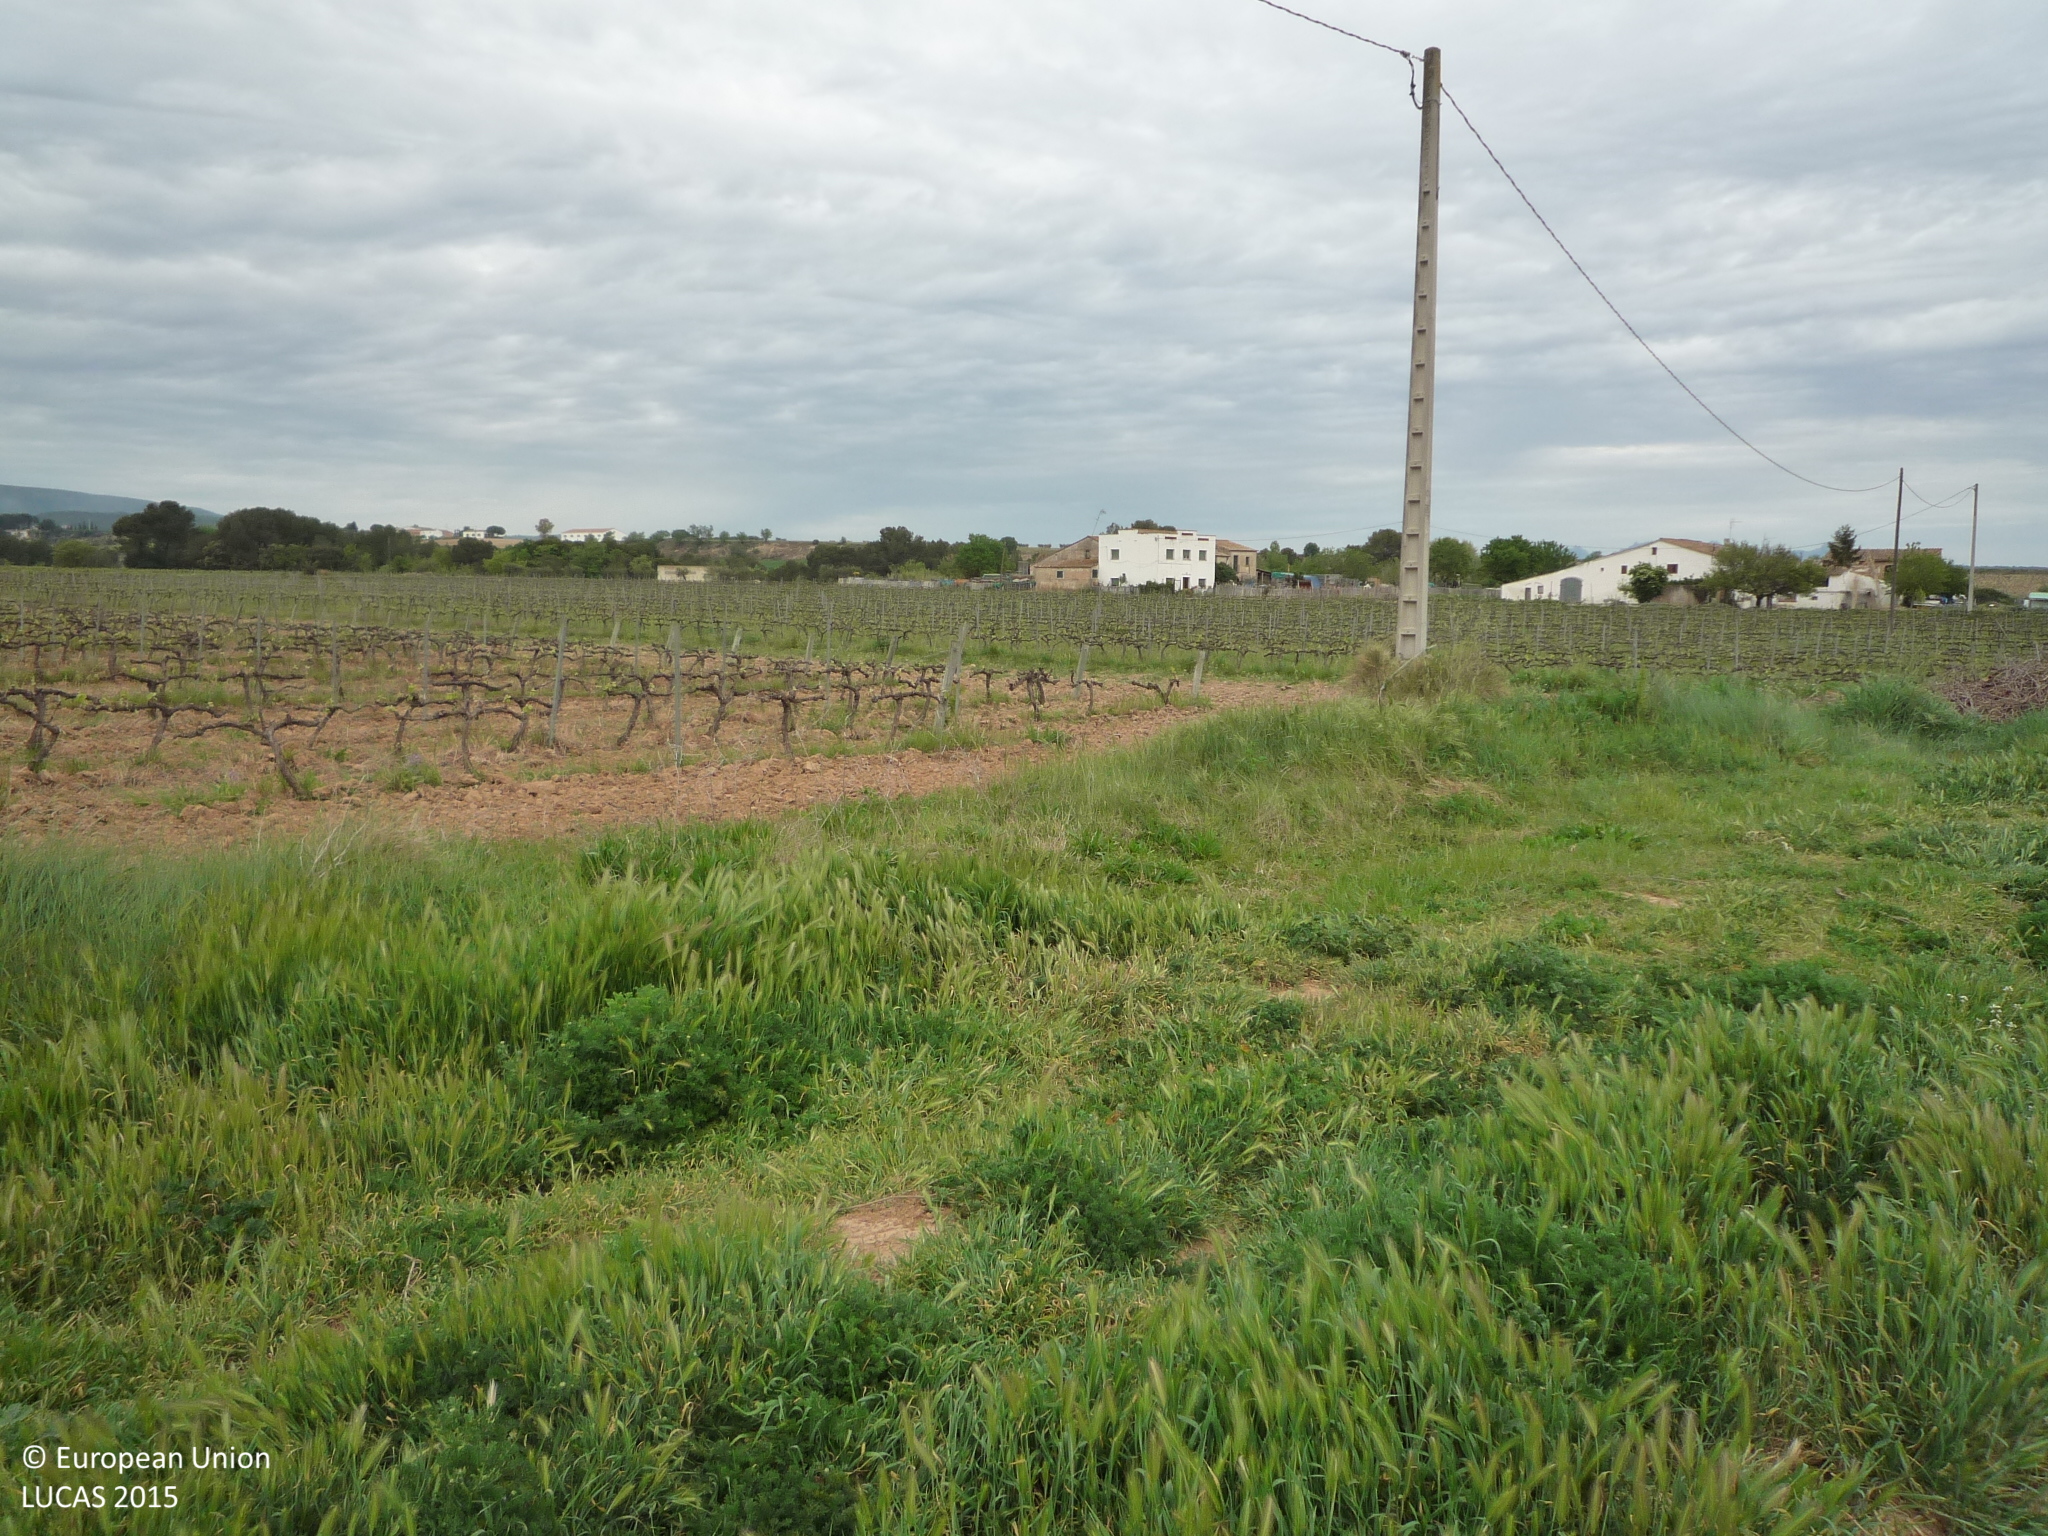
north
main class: Cropland
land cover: Vineyards
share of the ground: > 75 %
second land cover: Other bare soil
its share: > 75 %
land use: Agriculture (excluding fallow land and kitchen gardens)
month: April
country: ES
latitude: 41.4035
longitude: 1.6796
